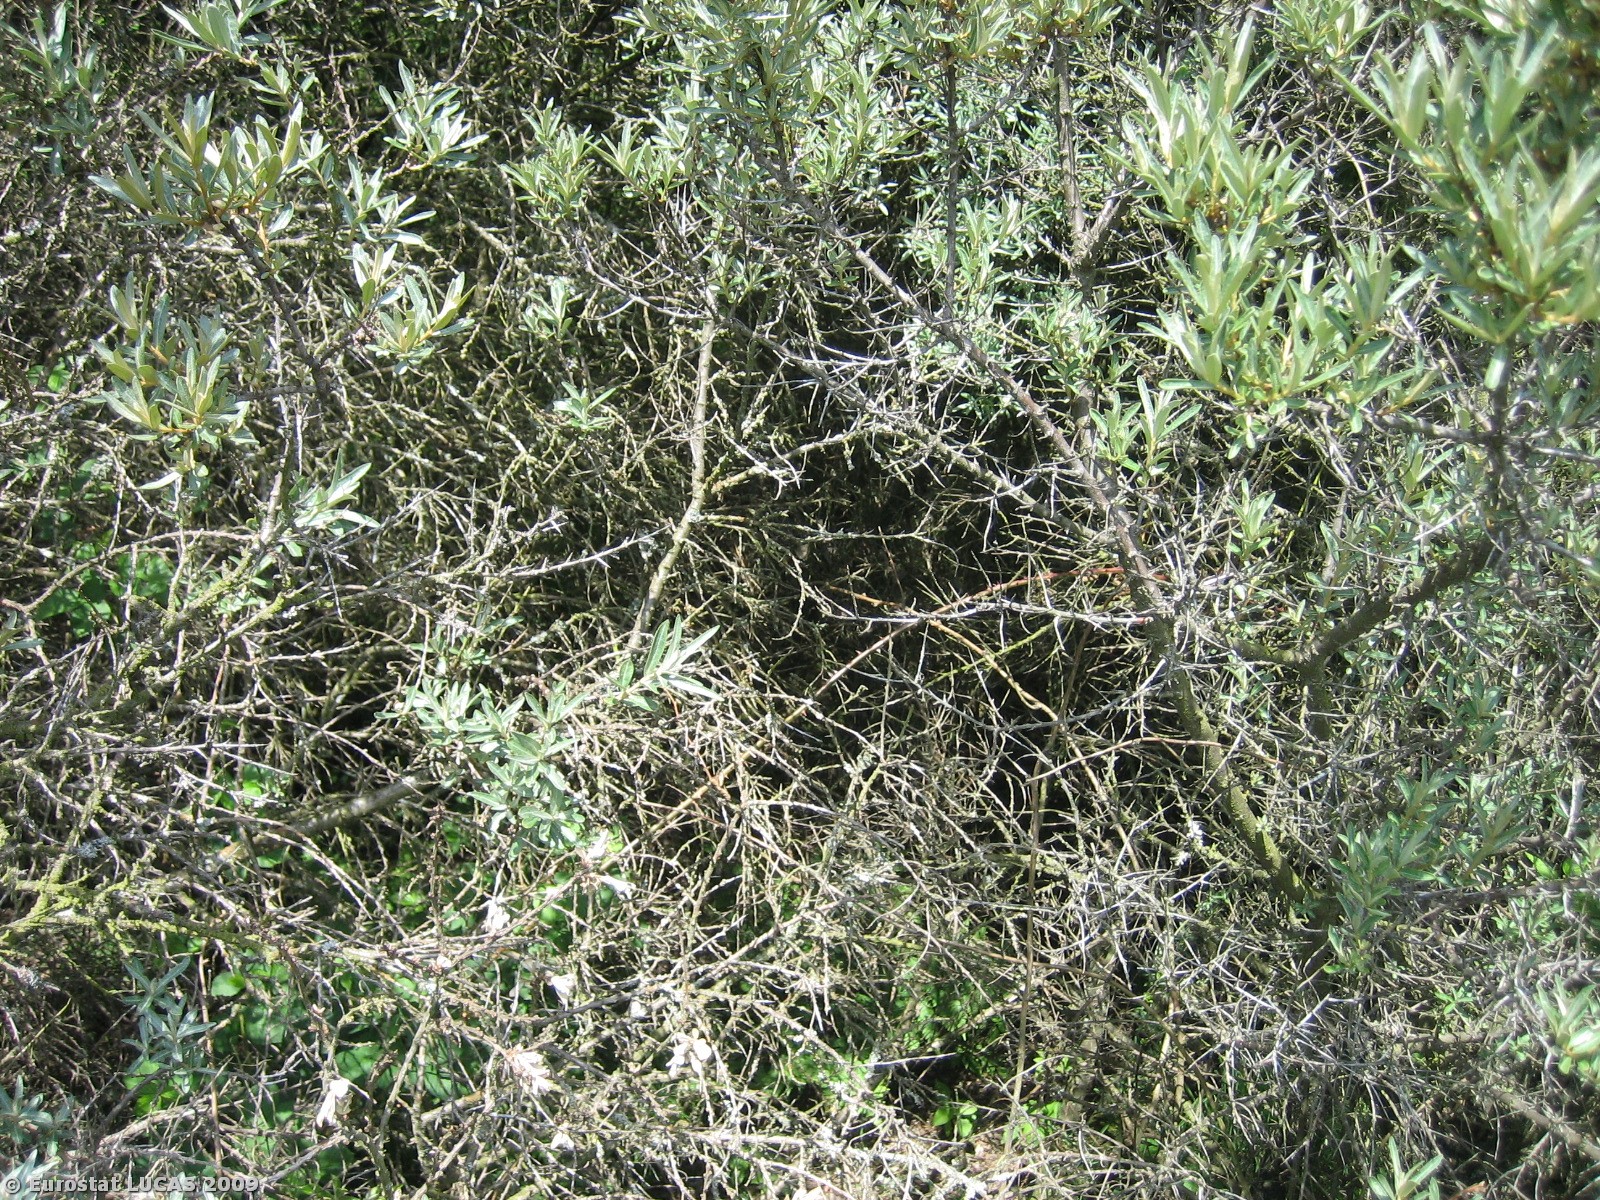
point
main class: Woodland
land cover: Broadleaved woodland
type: mesophytic deciduous forest
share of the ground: > 75 %
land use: Forestry
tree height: > 5 m
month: June
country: DK
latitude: 56.0616
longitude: 9.7273
